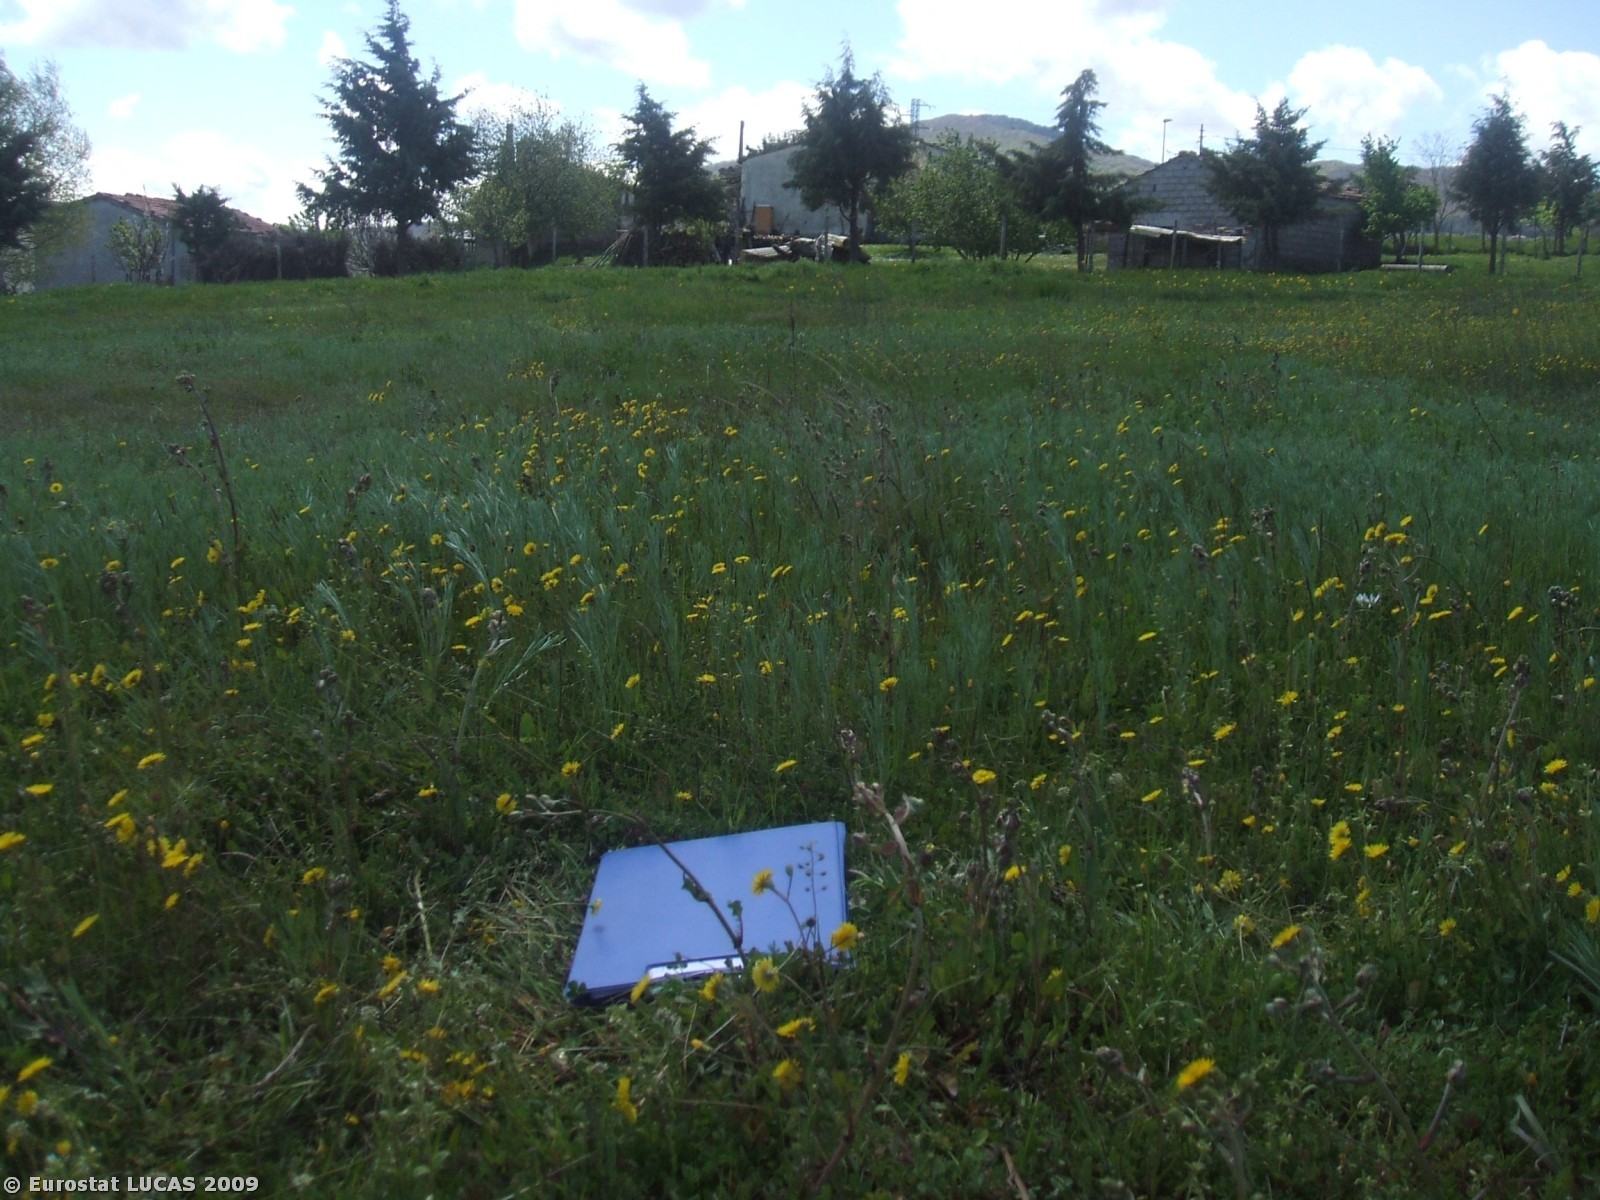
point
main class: Grassland
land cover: Grassland without tree/shrub cover
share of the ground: > 75 %
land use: Agriculture (excluding fallow land and kitchen gardens)
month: April
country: IT
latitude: 40.6019
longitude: 15.8272
